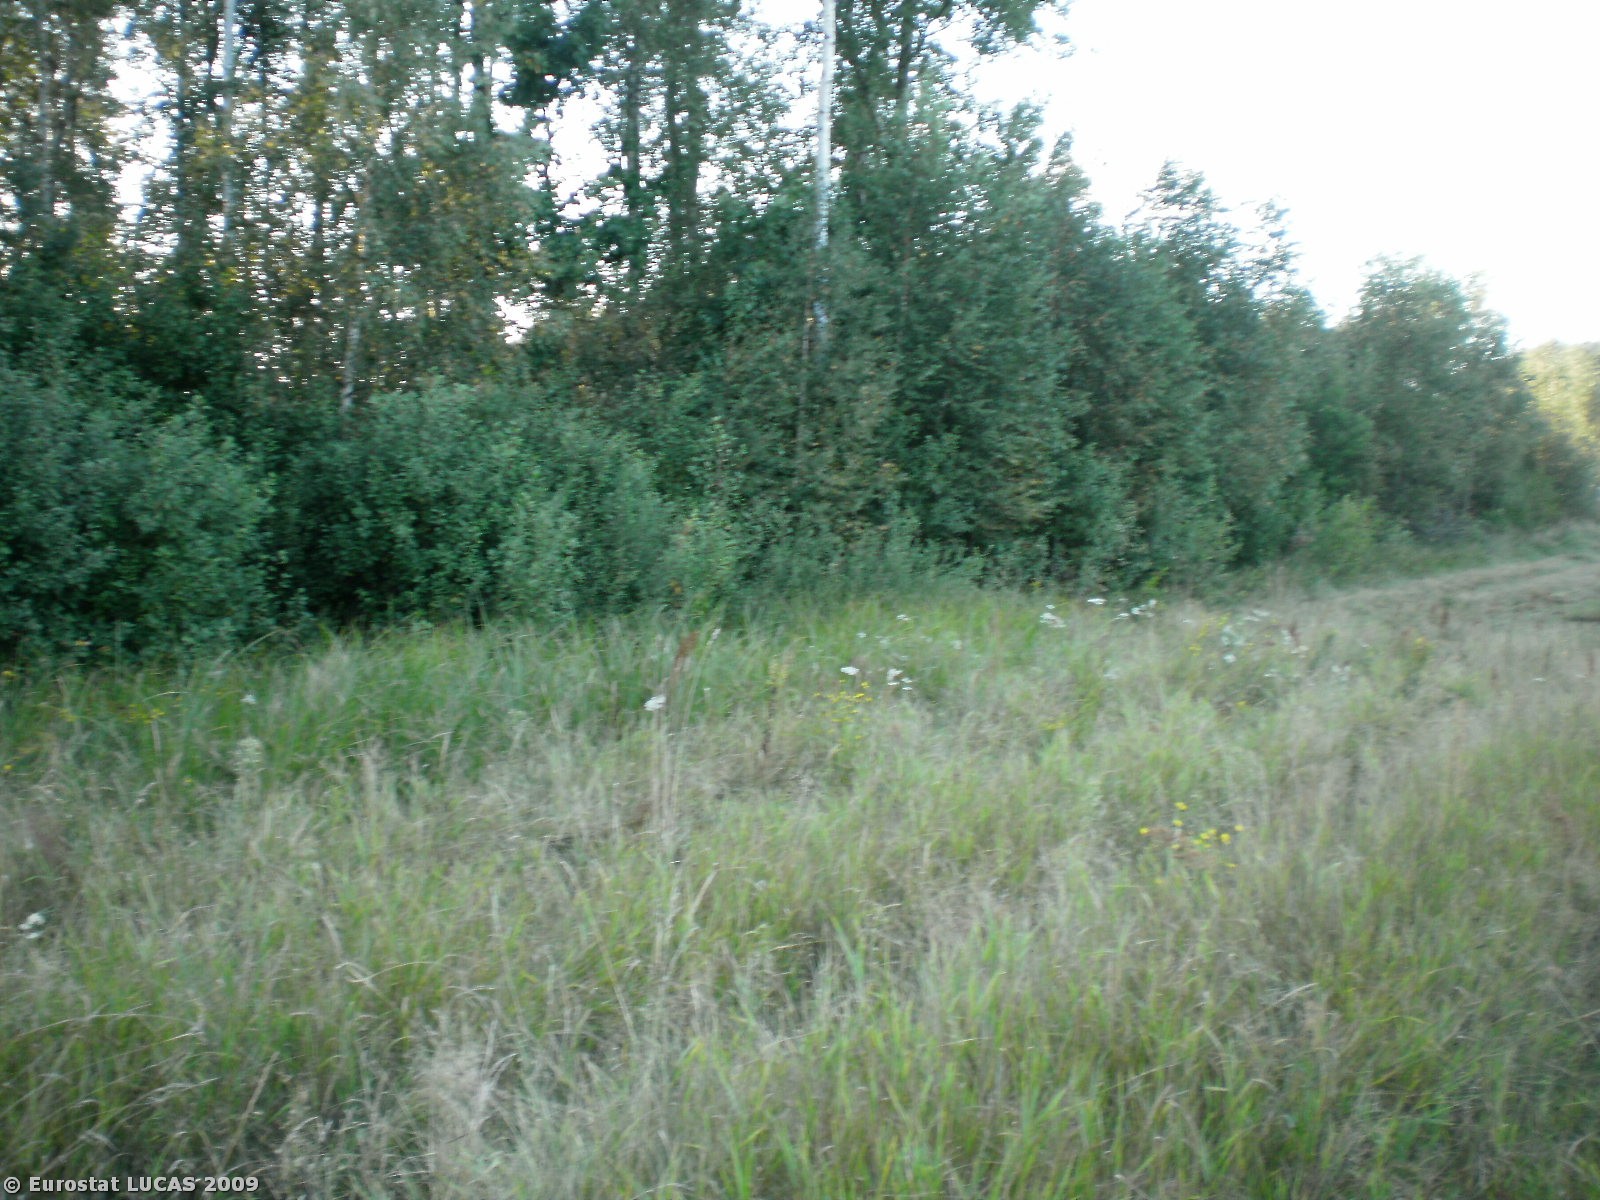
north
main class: Woodland
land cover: Coniferous woodland
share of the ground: > 75 %
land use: Forestry
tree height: < 5 m
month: August
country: PL
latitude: 52.5725
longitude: 21.7554
